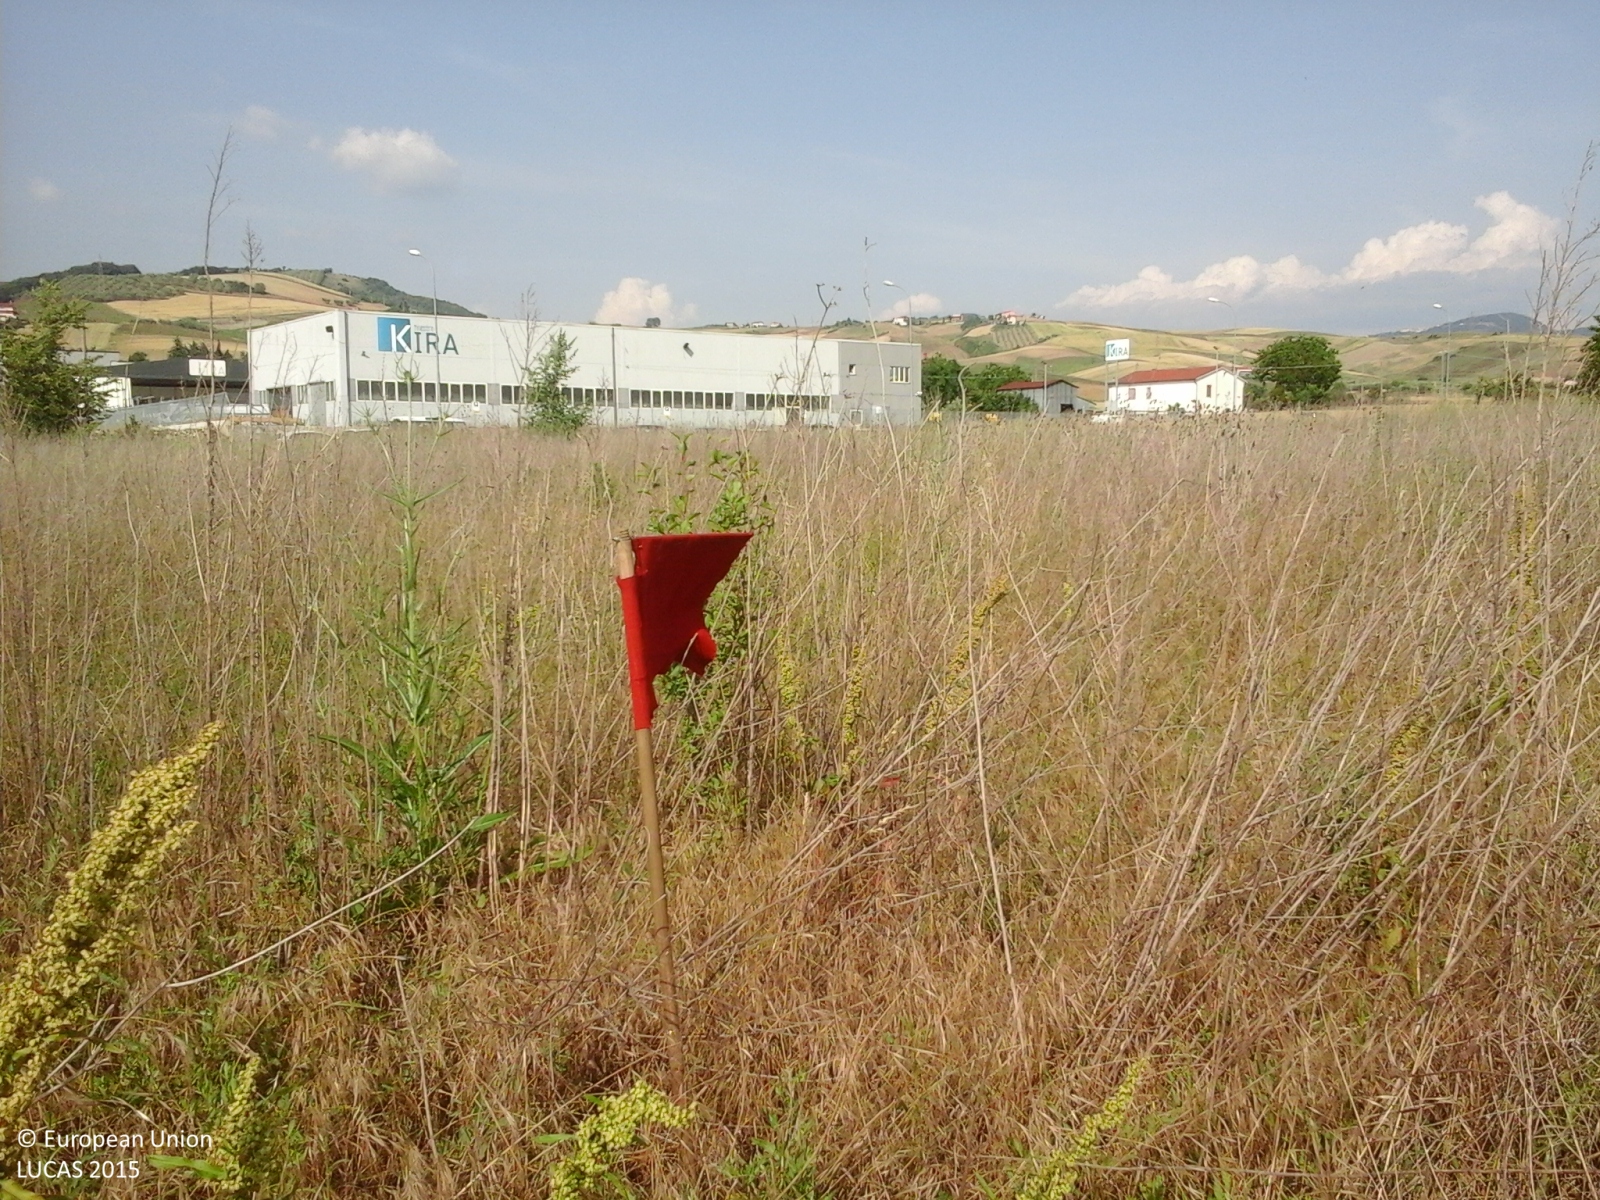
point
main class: Grassland
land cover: Grassland without tree/shrub cover
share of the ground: > 75 %
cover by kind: herbaceous plants 100 %
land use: Abandoned areas
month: June
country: IT
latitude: 41.0573
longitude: 15.1330
